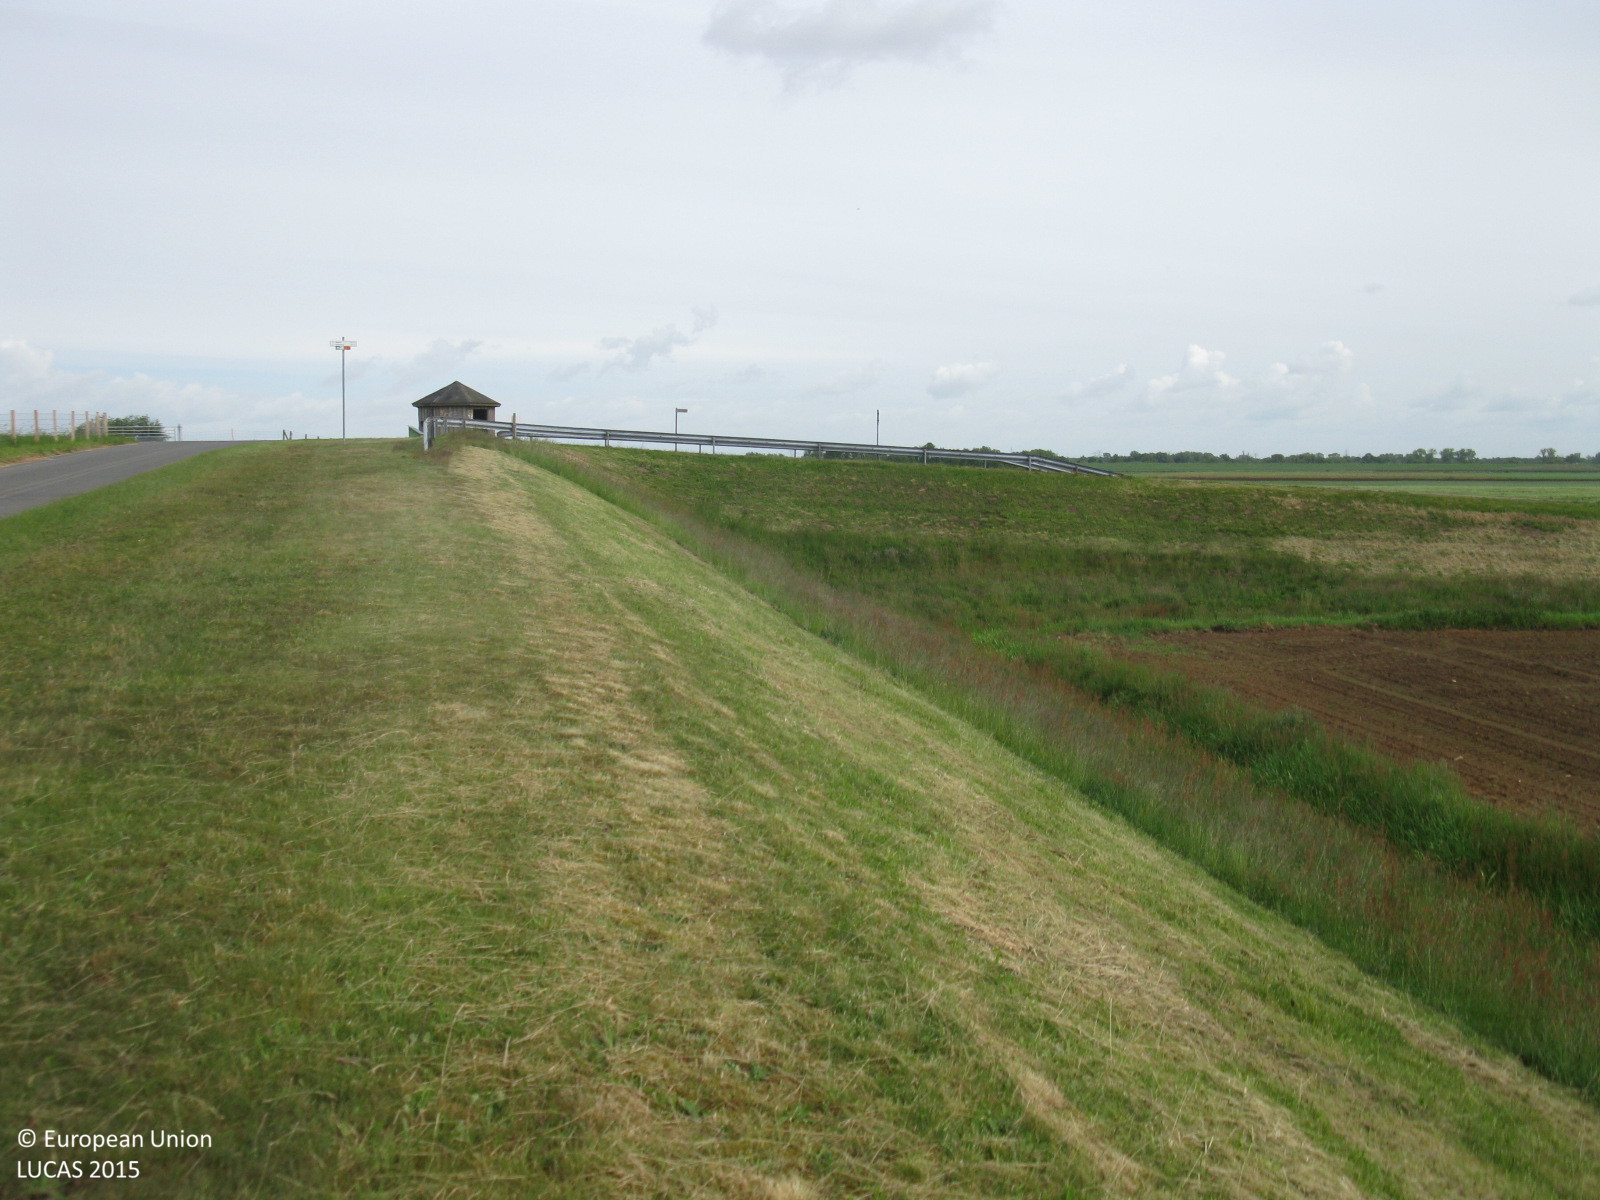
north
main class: Grassland
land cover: Grassland without tree/shrub cover
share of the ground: > 75 %
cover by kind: herbaceous plants 100 %
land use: Protection infrastructures
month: June
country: DE
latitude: 53.0841
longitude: 7.2982
